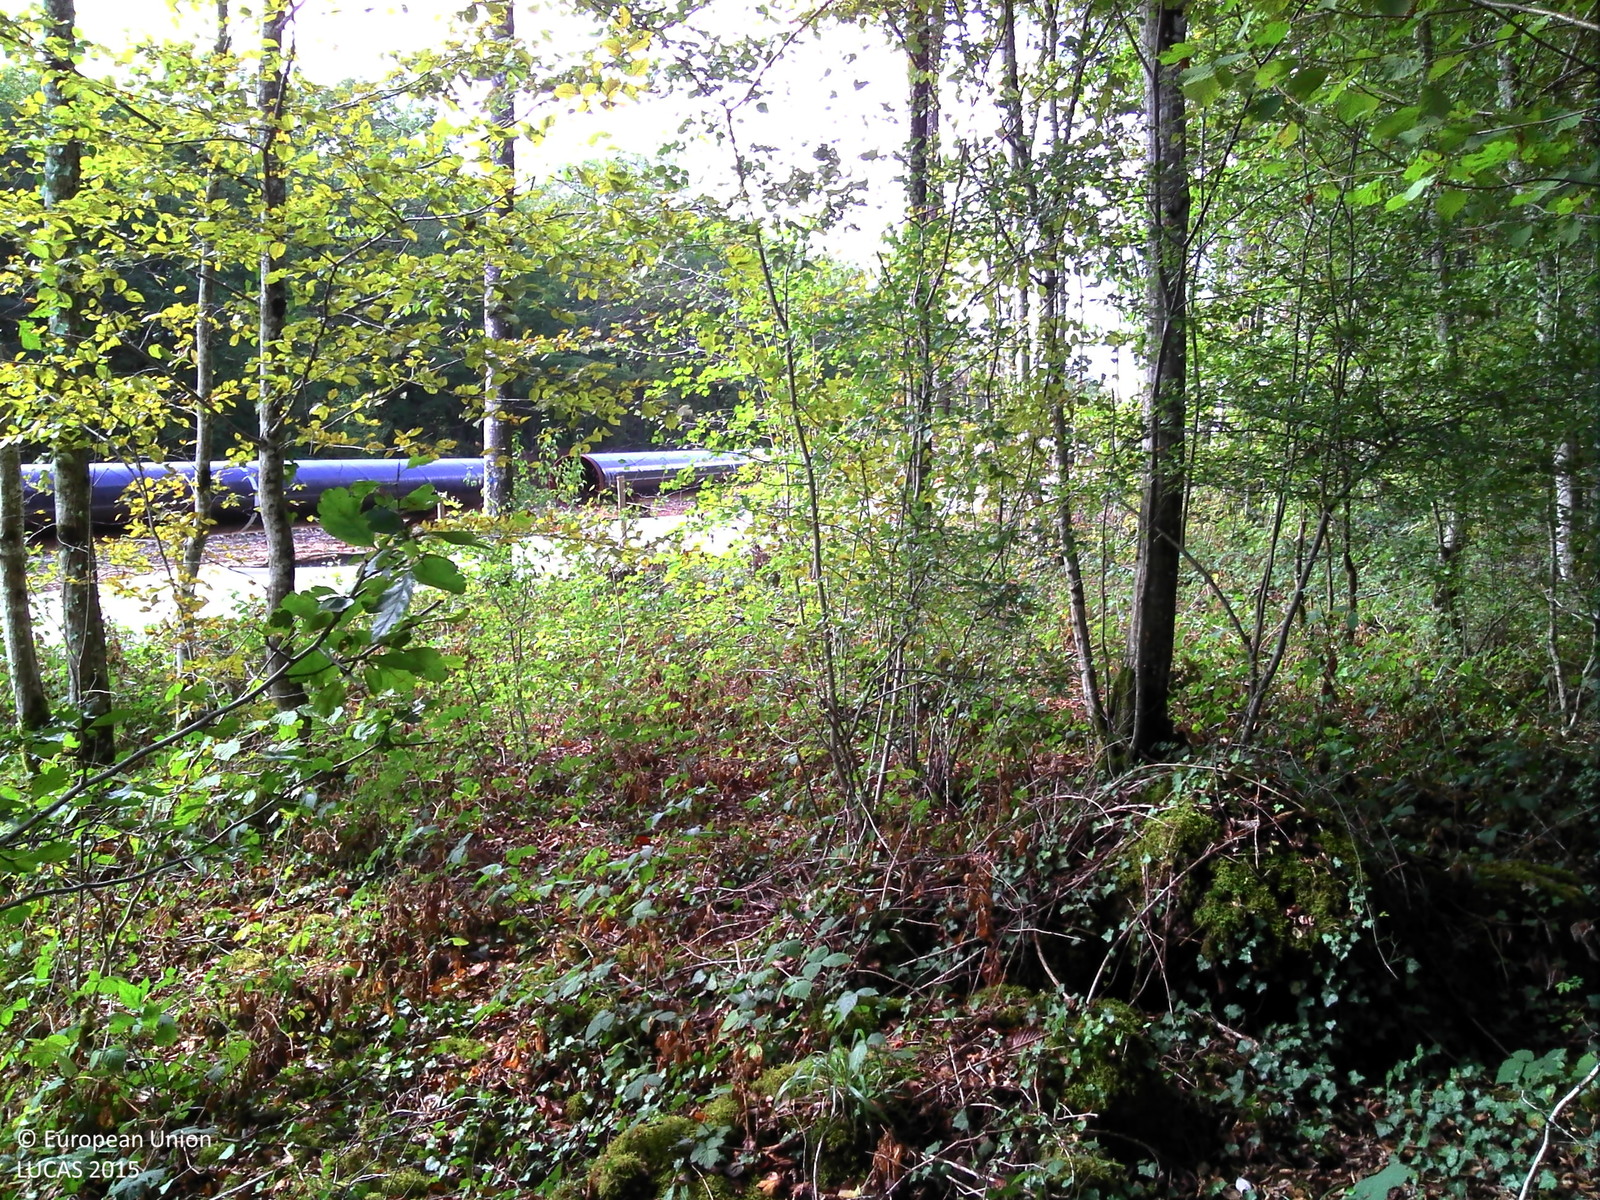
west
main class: Woodland
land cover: Broadleaved woodland
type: mesophytic deciduous forest
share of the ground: > 75 %
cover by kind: broadleaved forest trees 90 %, herbaceous plants 10 %
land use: Forestry
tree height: > 5 m
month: September
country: FR
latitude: 48.0587
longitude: 4.6715
